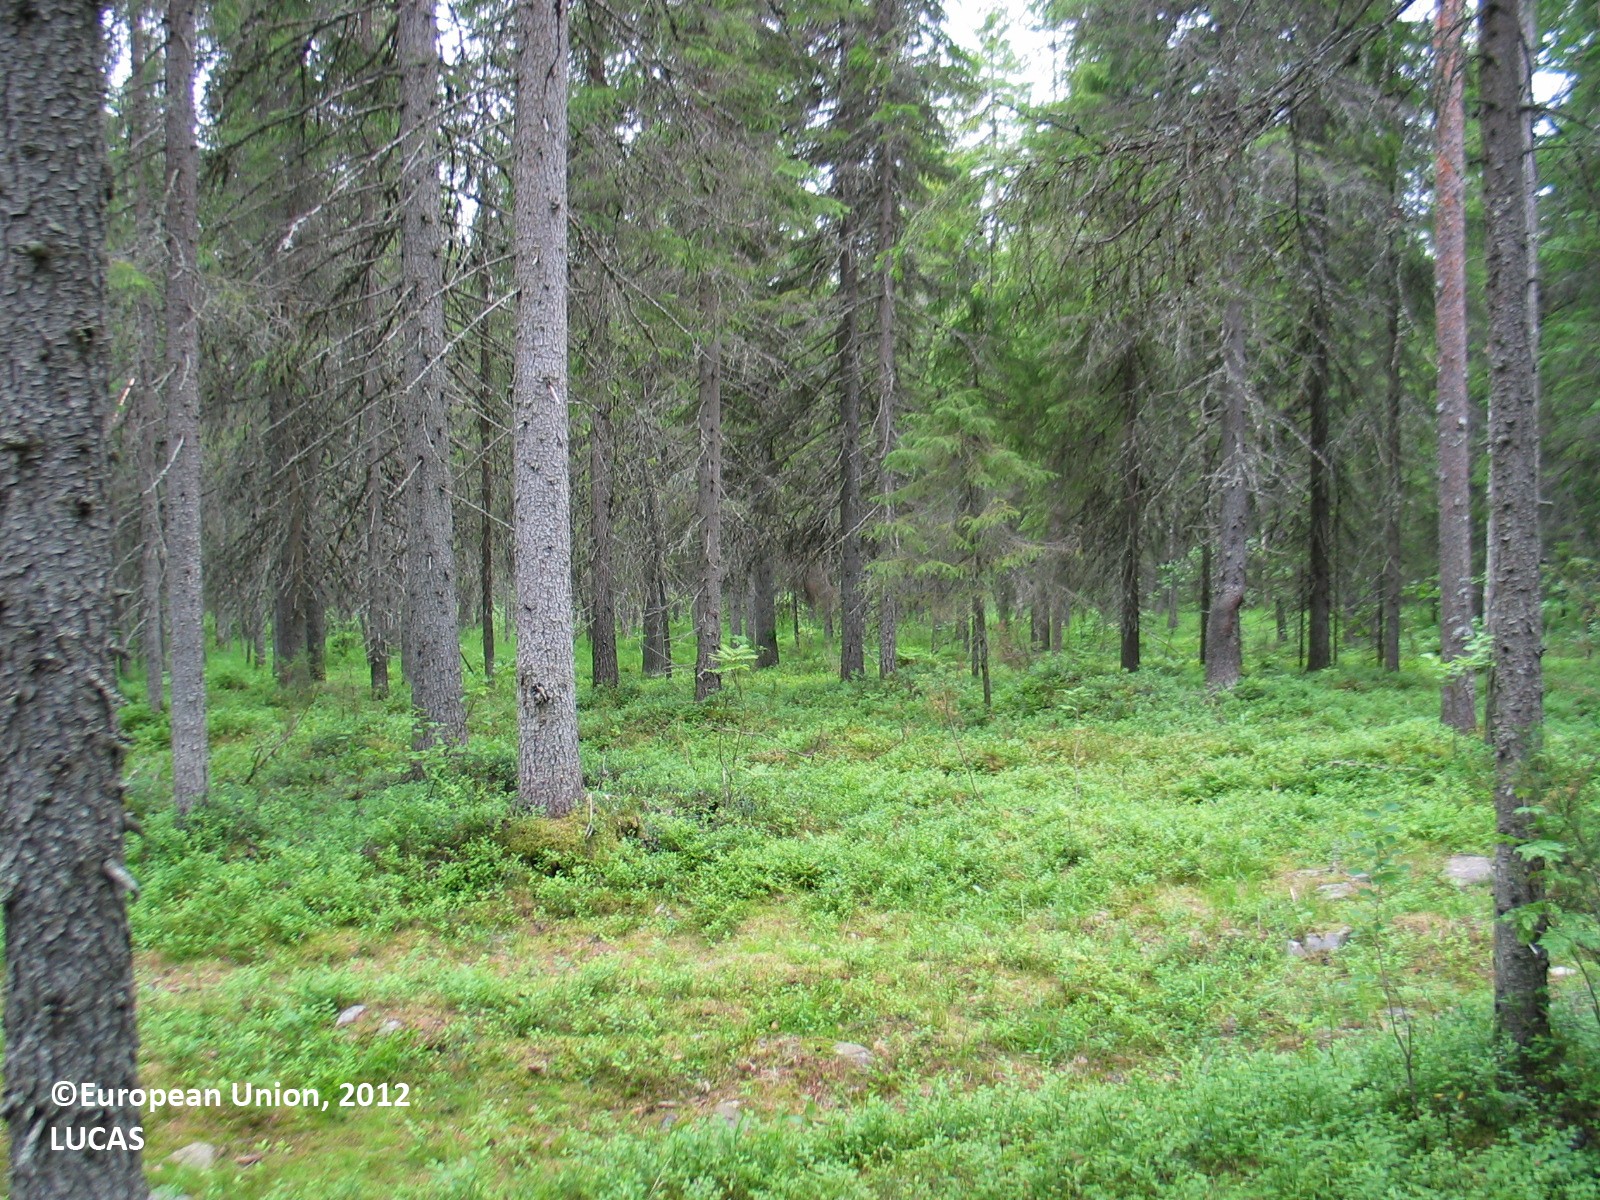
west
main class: Woodland
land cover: Spruce dominated coniferous woodland
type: boreal forest
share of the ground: 50 - 75 %
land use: Forestry
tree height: > 5 m
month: July
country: FI
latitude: 65.7633
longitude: 25.2412
